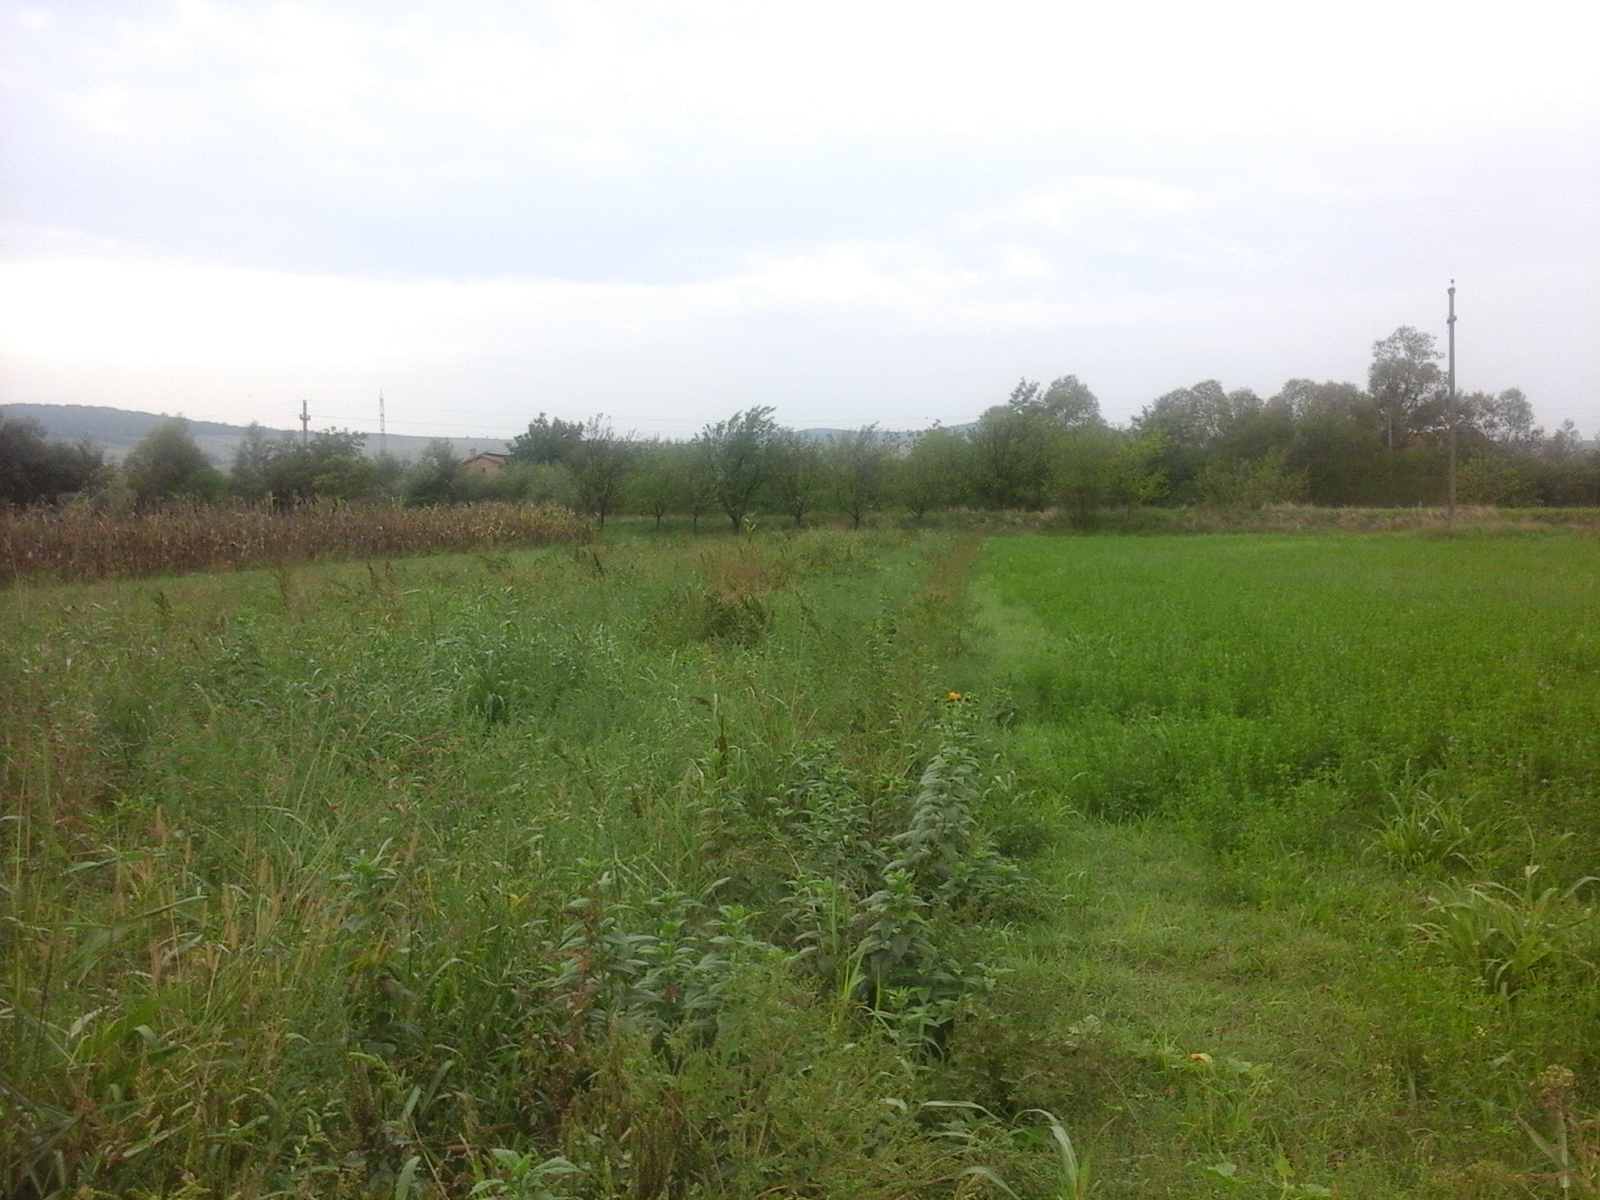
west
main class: Cropland
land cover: Maize
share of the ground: > 75 %
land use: Agriculture (excluding fallow land and kitchen gardens)
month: September
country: RO
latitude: 45.7722
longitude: 23.0045
